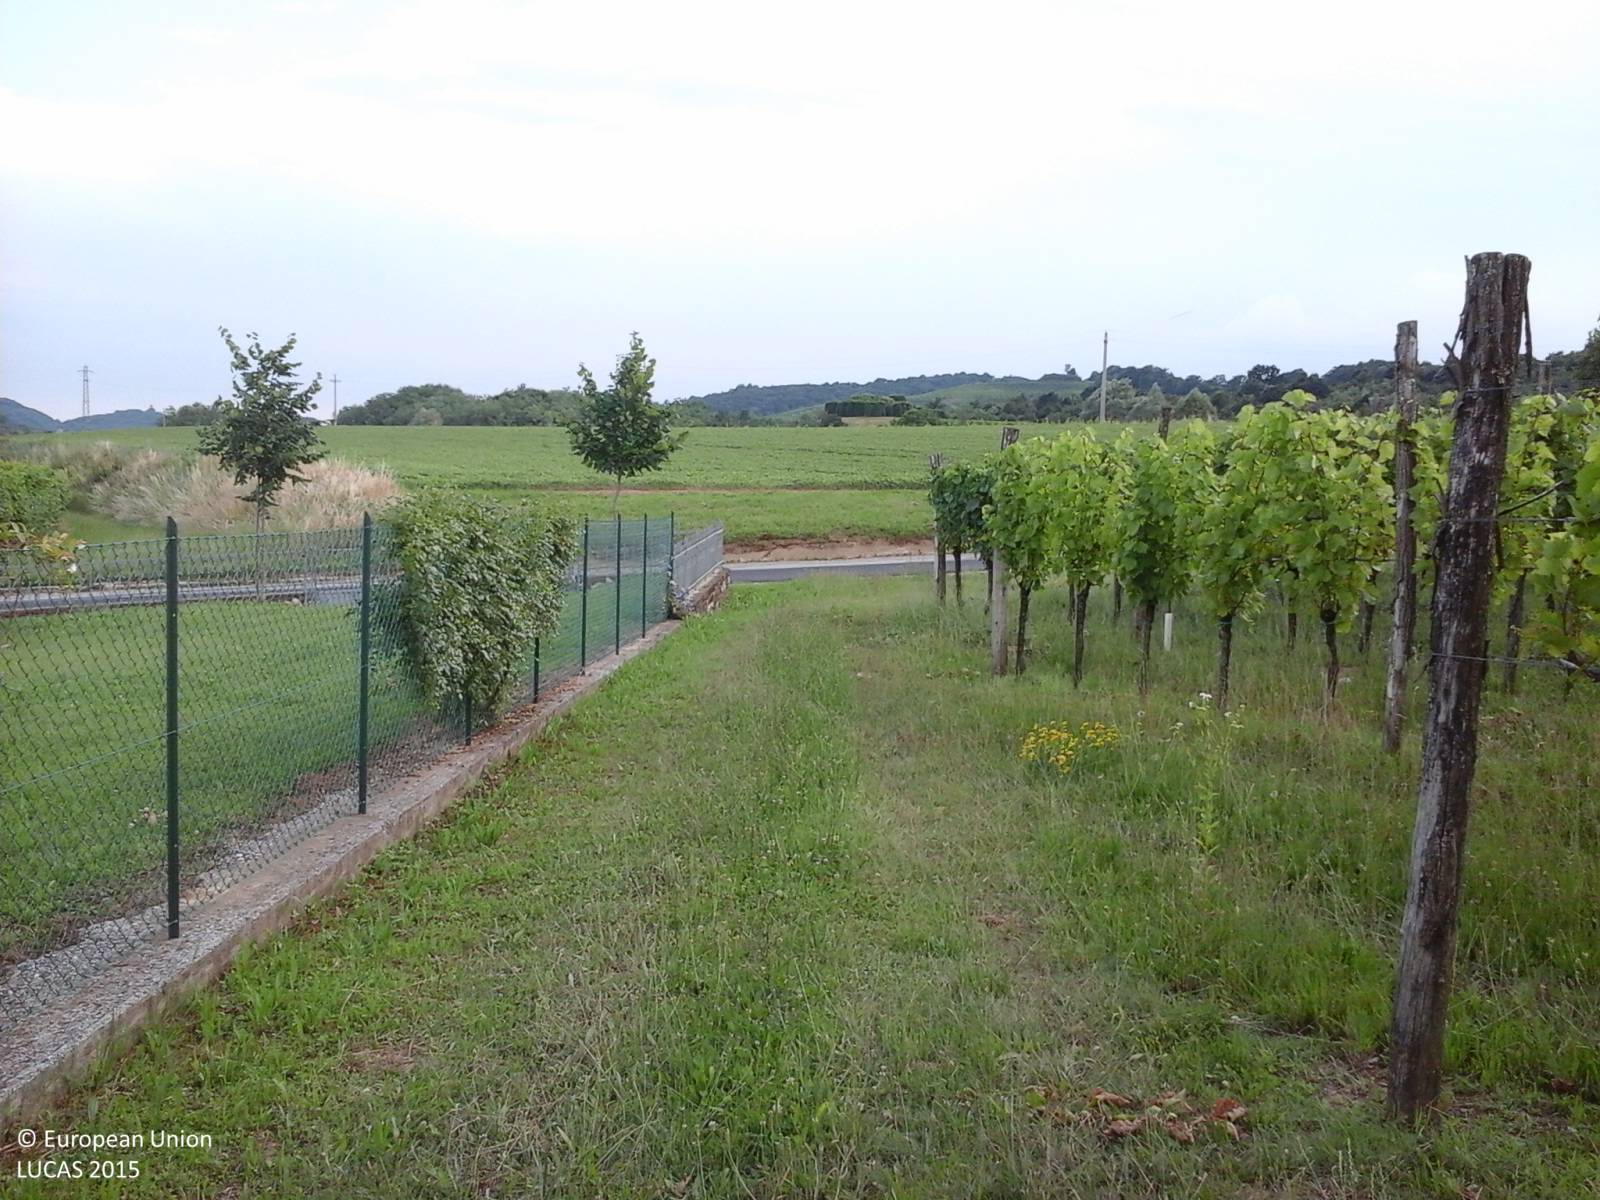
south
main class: Cropland
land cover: Vineyards
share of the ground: 25 - 50 %
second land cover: Grassland without tree/shrub cover
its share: 50 - 75 %
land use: Agriculture (excluding fallow land and kitchen gardens)
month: June
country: IT
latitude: 46.0245
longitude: 13.4712
